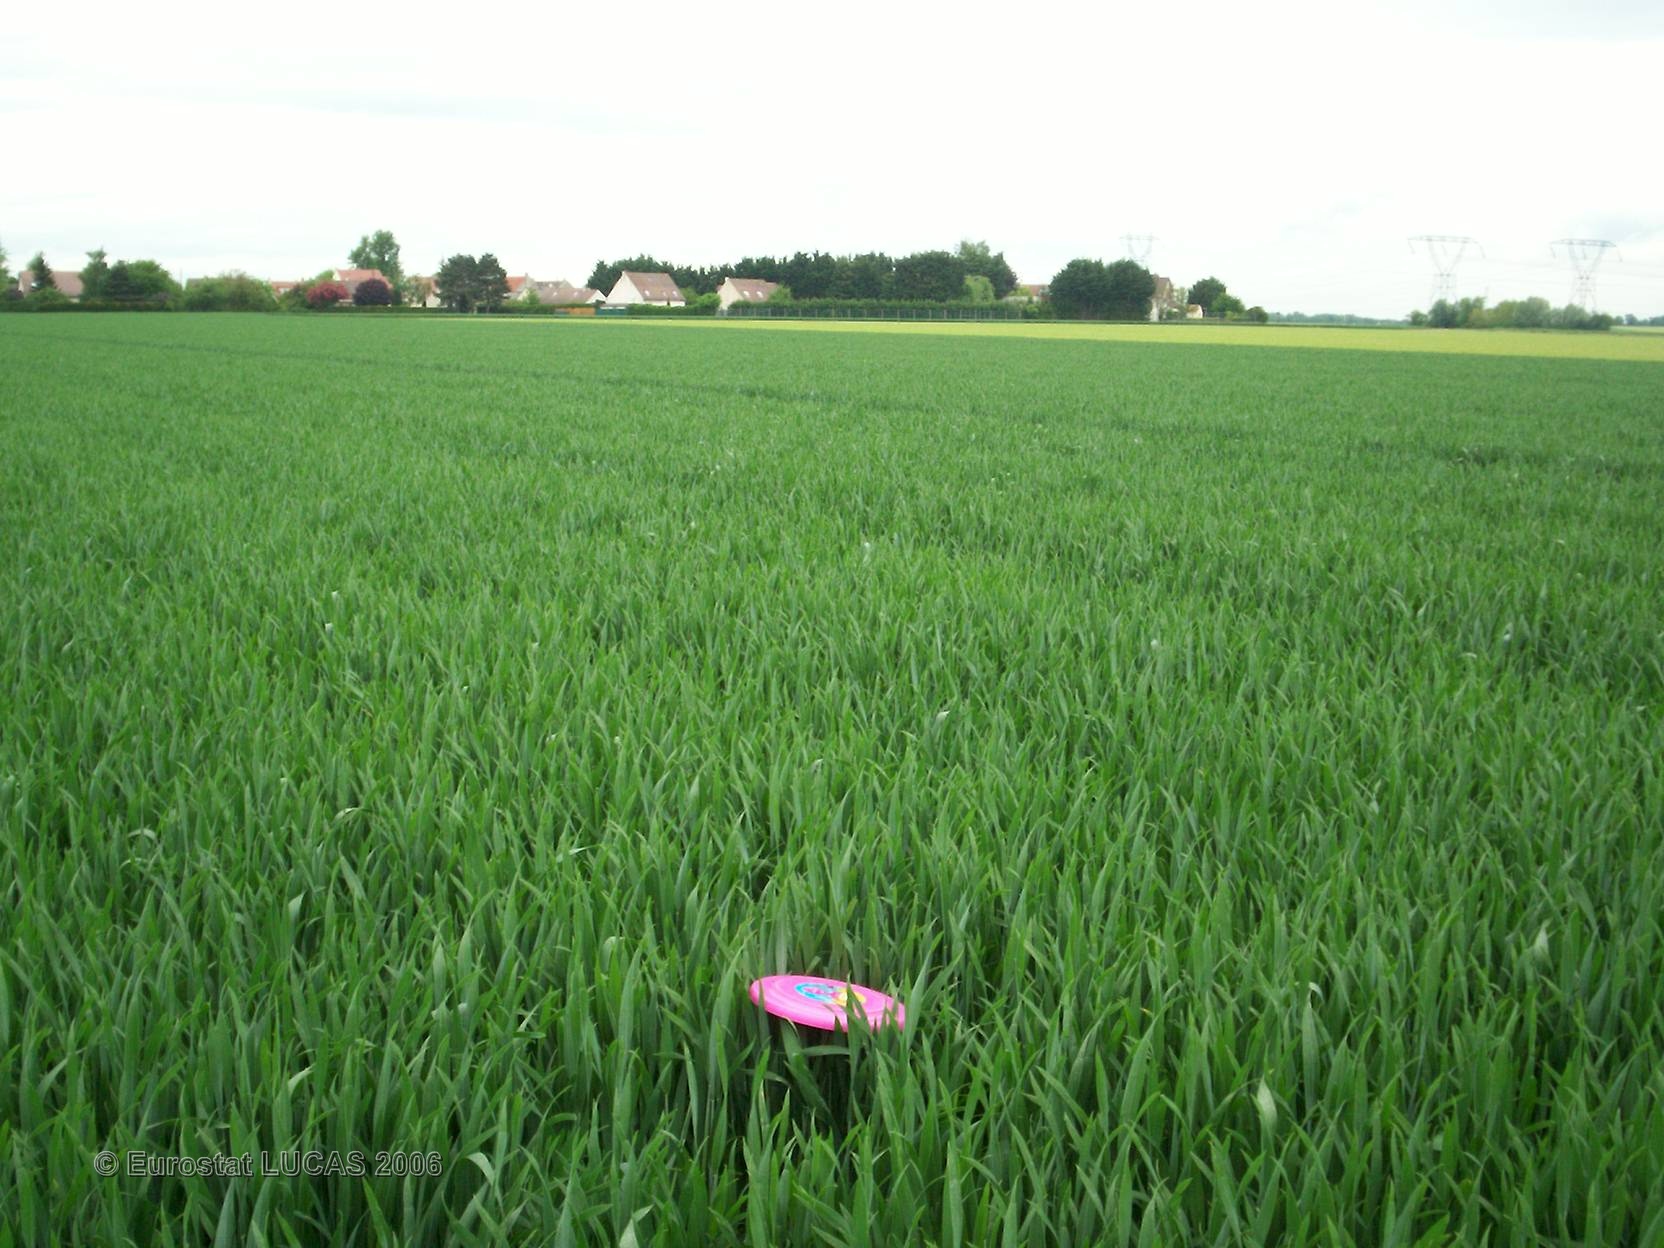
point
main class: Cropland
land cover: Common wheat
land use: Agriculture (excluding fallow land and kitchen gardens)
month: May
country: FR
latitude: 48.6159
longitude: 2.7333
